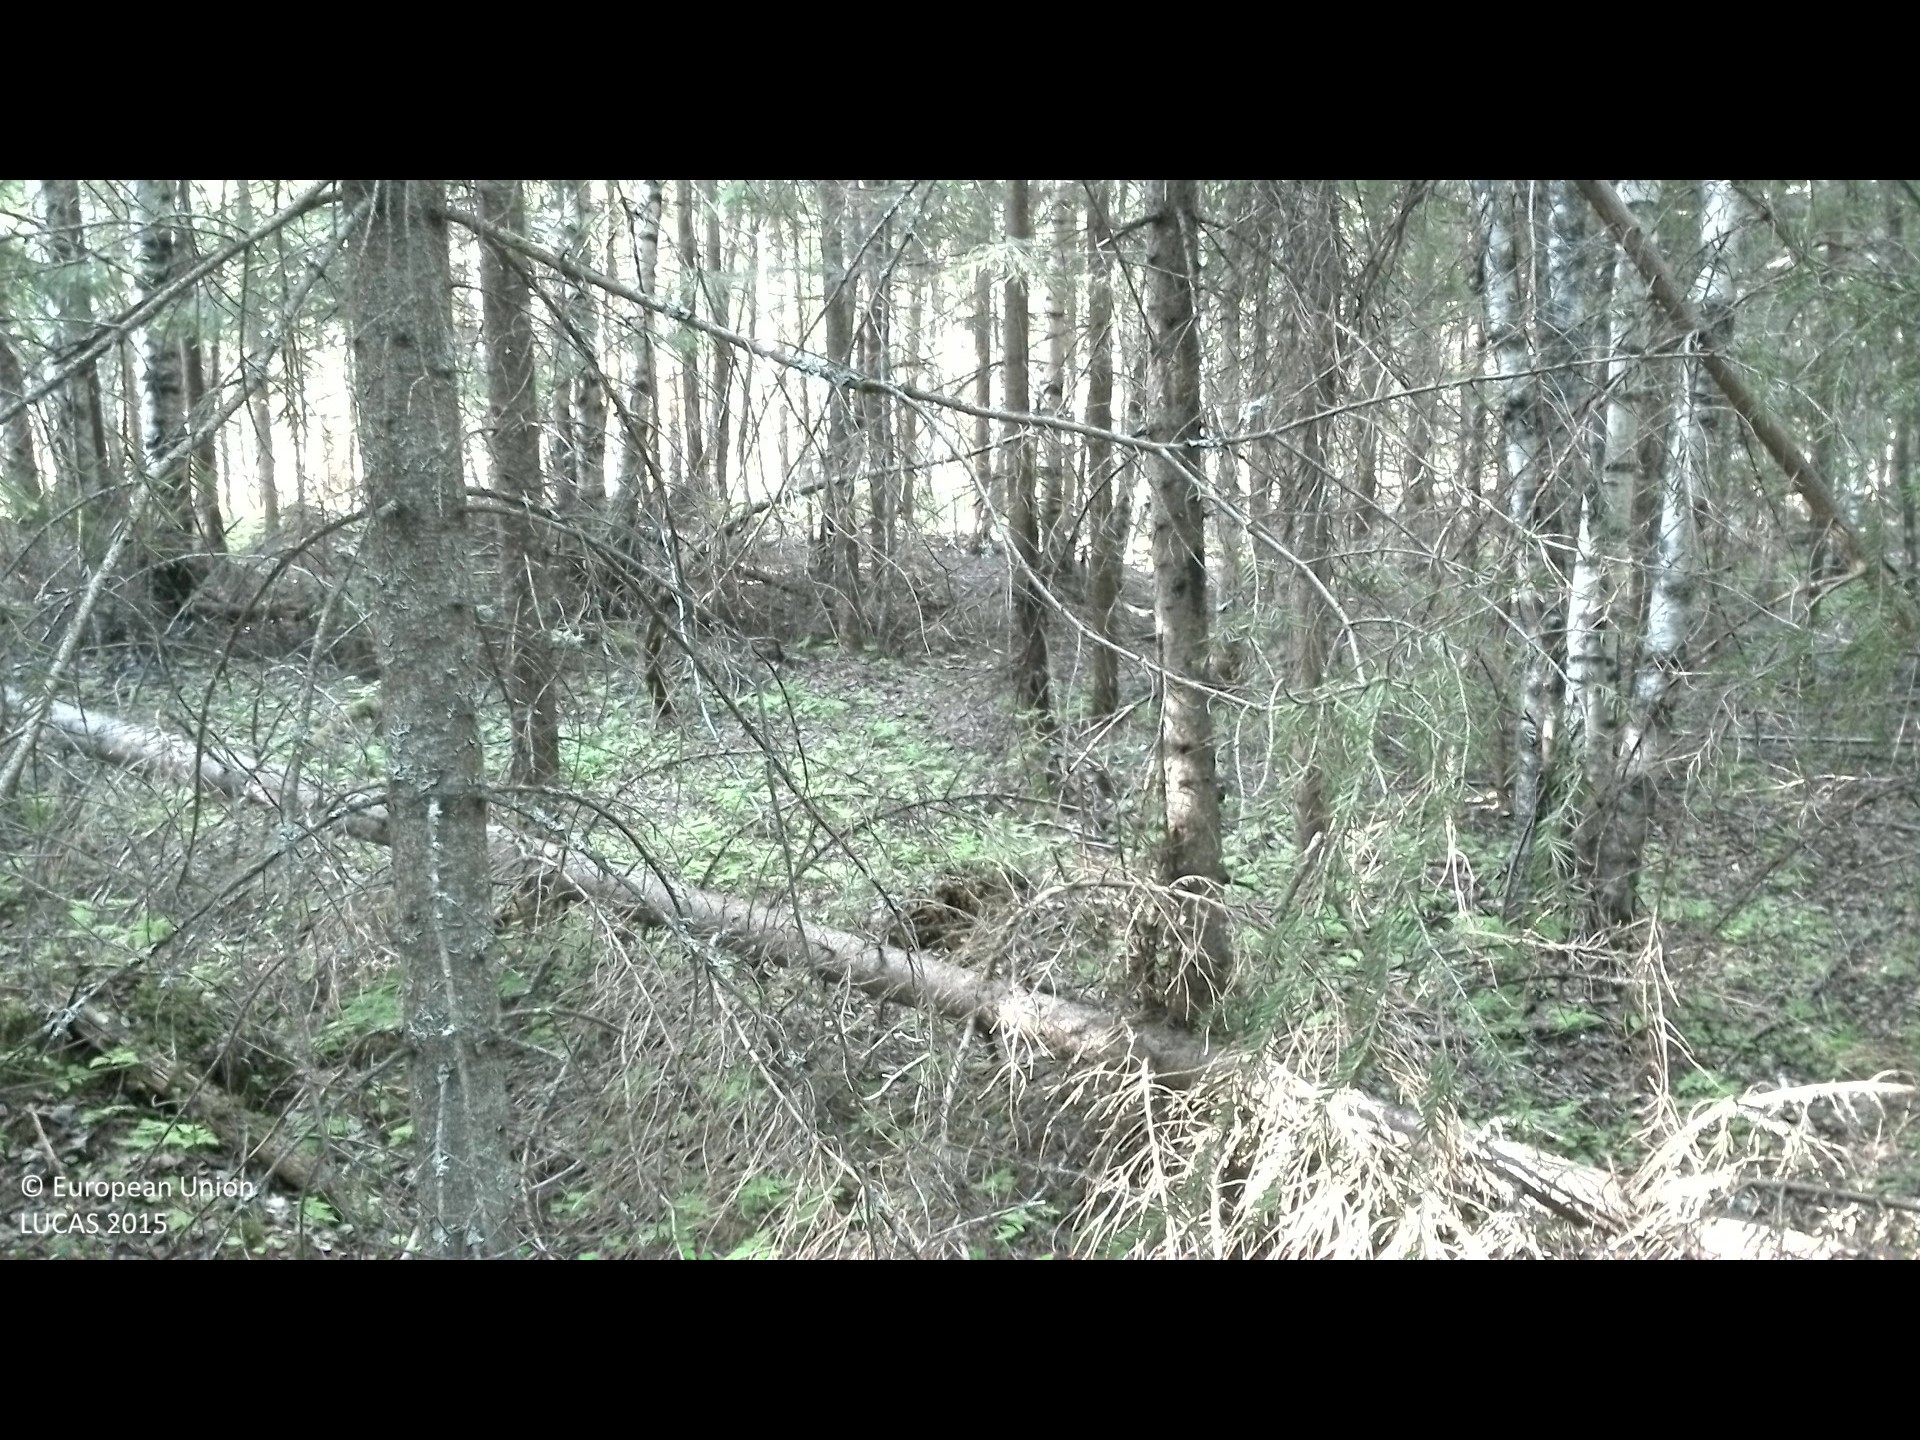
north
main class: Woodland
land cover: Spruce dominated mixed woodland
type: boreal forest
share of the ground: > 75 %
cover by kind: coniferous forest trees 45 %, broadleaved forest trees 30 %, herbaceous plants 25 %
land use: Forestry
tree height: > 5 m
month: June
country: SE
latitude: 62.2174
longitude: 17.3085
